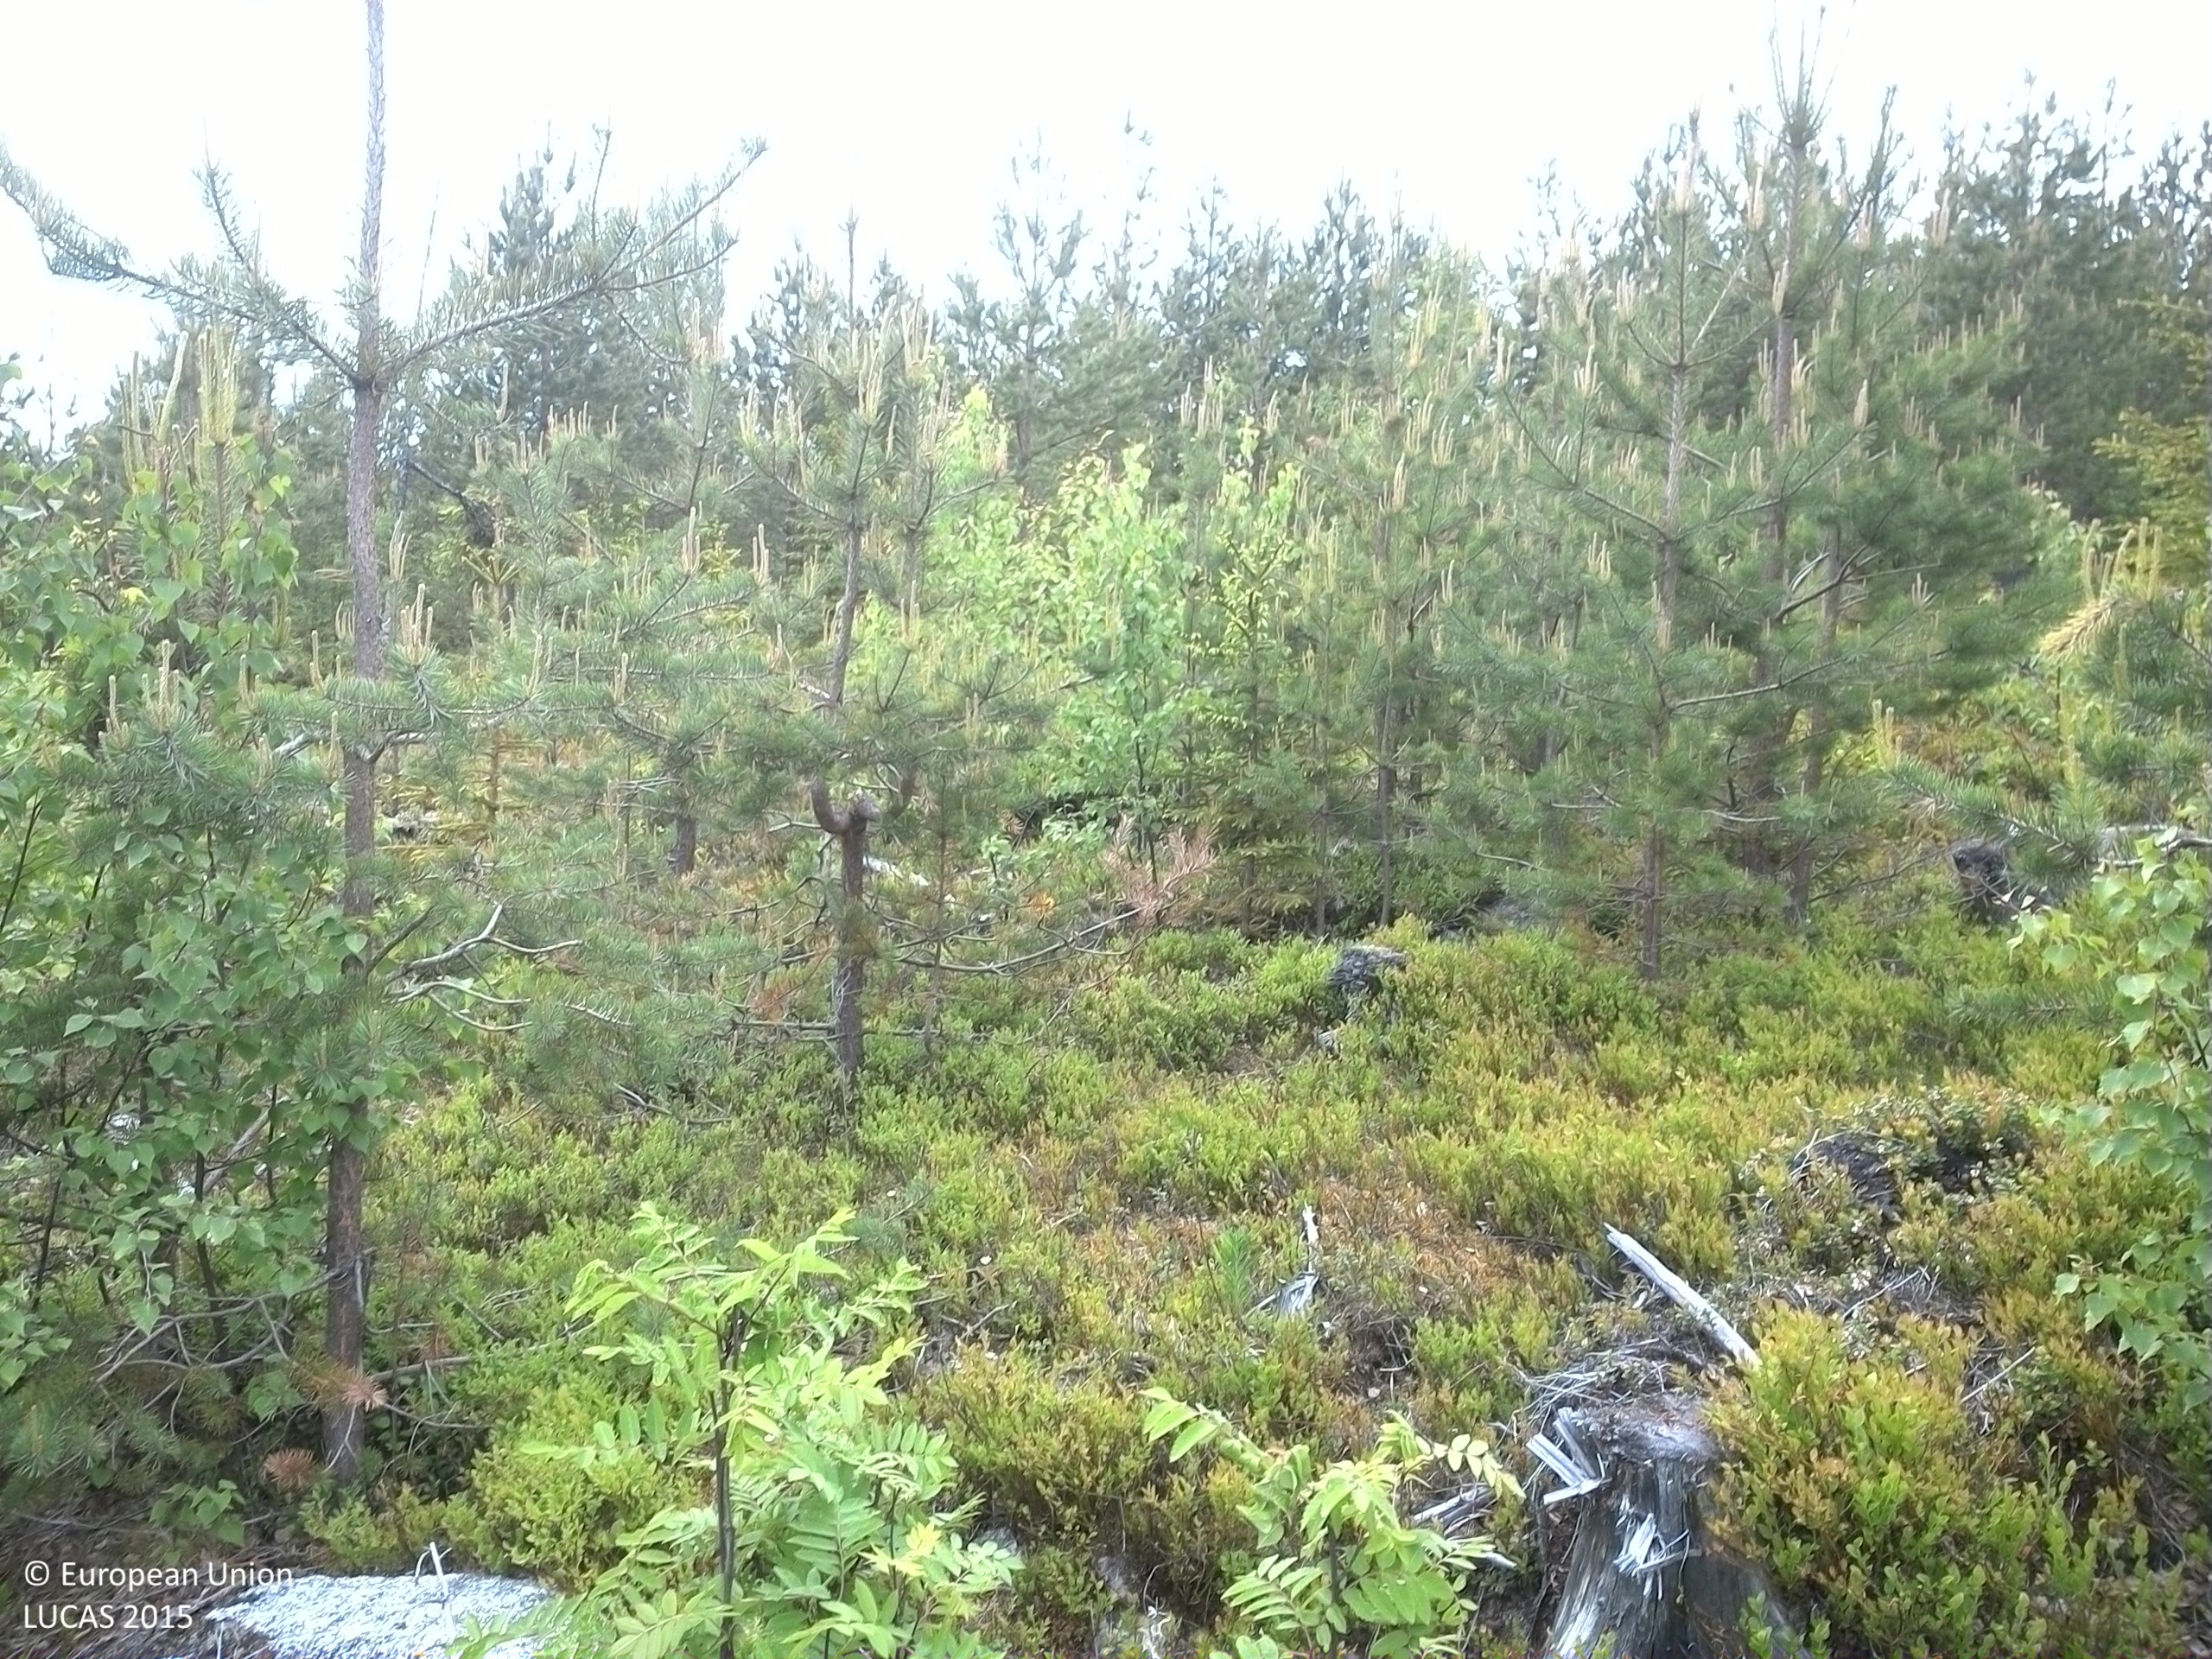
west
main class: Woodland
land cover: Pine dominated mixed woodland
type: exotic forest
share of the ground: 50 - 75 %
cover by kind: shrubs 45 %, coniferous forest trees 35 %, broadleaved forest trees 20 %
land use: Forestry
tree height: < 5 m
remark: Clear cut
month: June
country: SE
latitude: 63.4805
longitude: 18.1454
